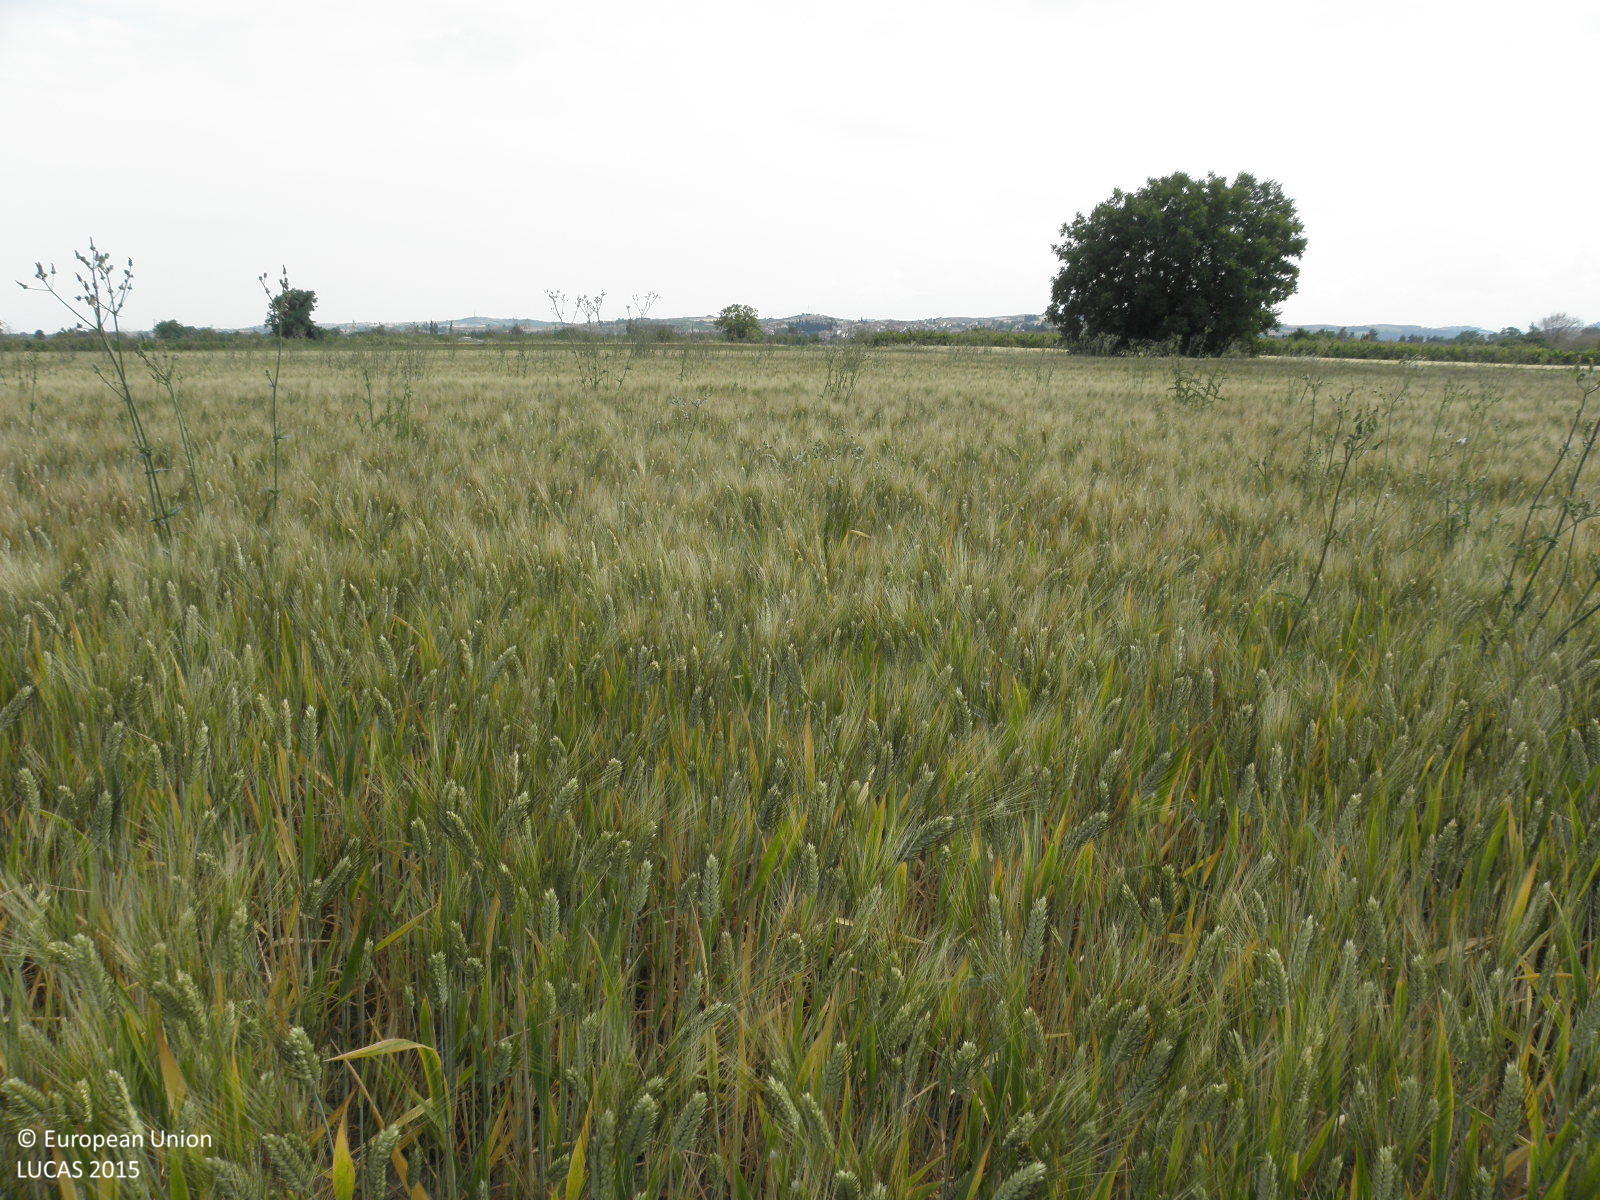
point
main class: Cropland
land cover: Common wheat
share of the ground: > 75 %
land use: Agriculture (excluding fallow land and kitchen gardens)
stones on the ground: < 10 %
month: June
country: GR
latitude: 40.5187
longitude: 22.5481
